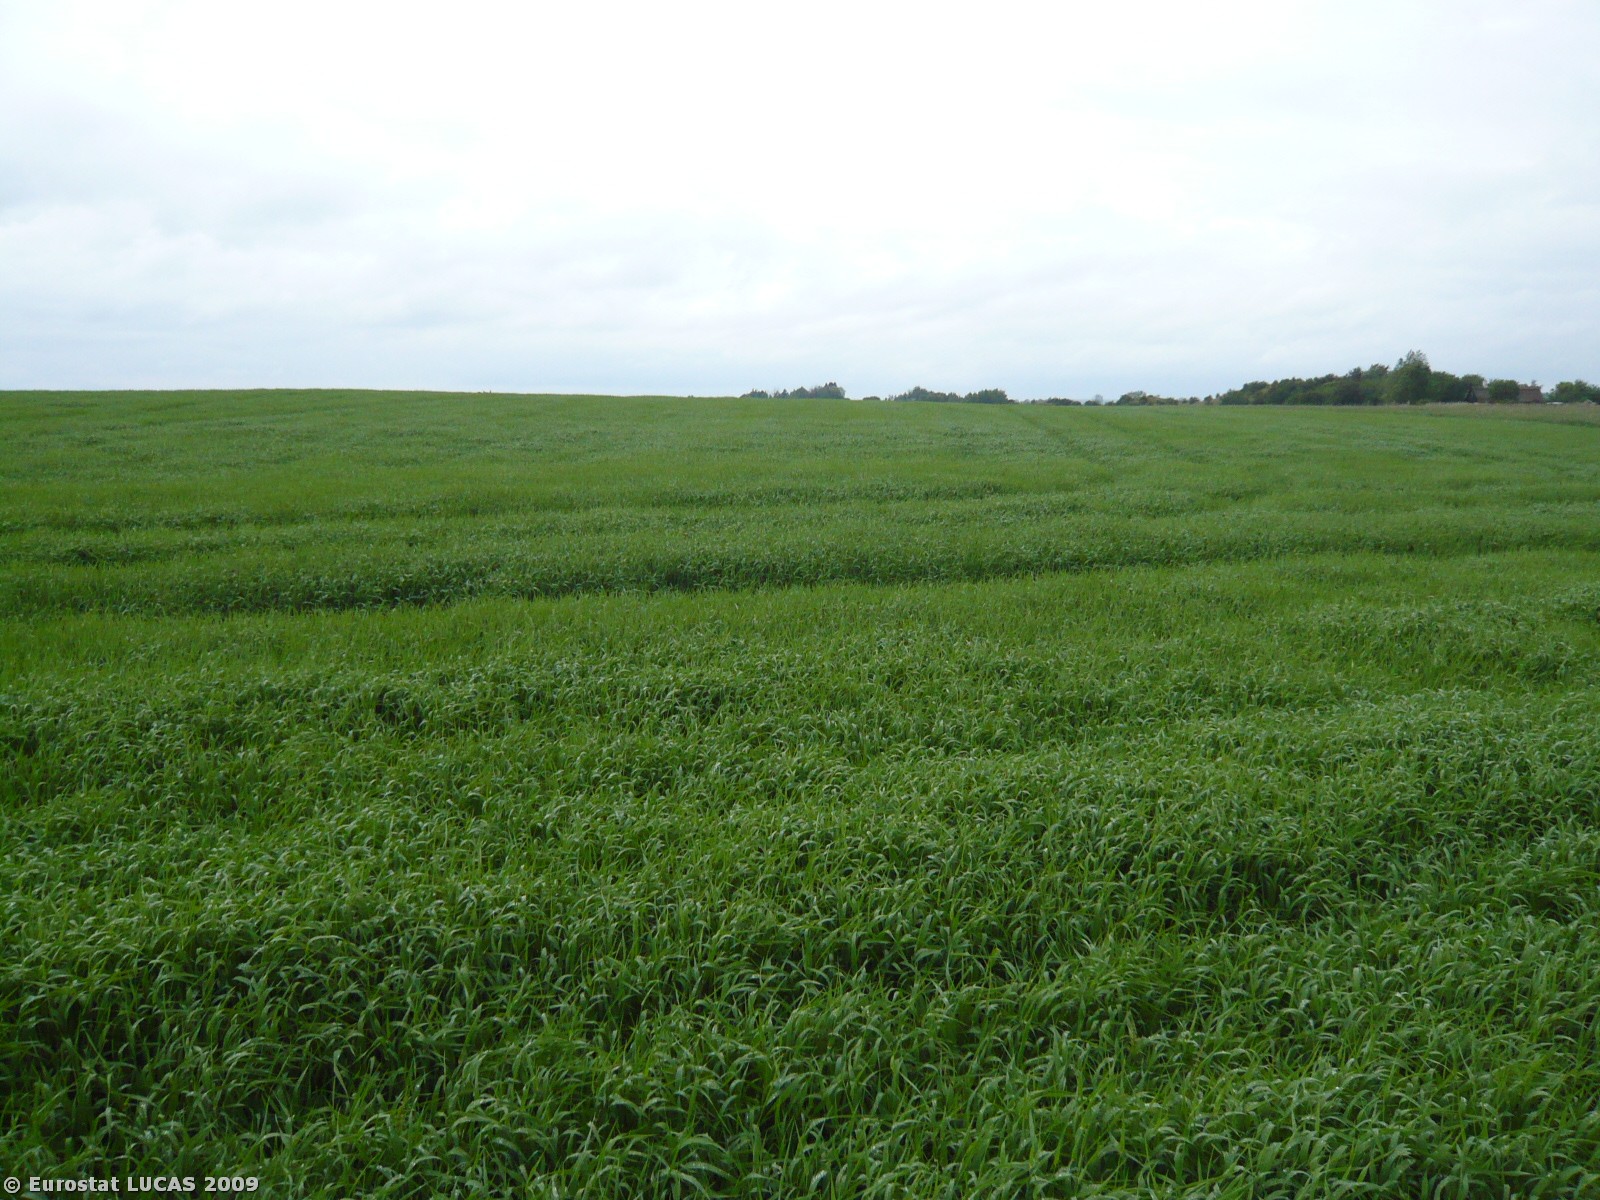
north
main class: Cropland
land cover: Barley
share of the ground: > 75 %
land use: Agriculture (excluding fallow land and kitchen gardens)
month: June
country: DK
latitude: 54.9149
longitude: 11.9175
